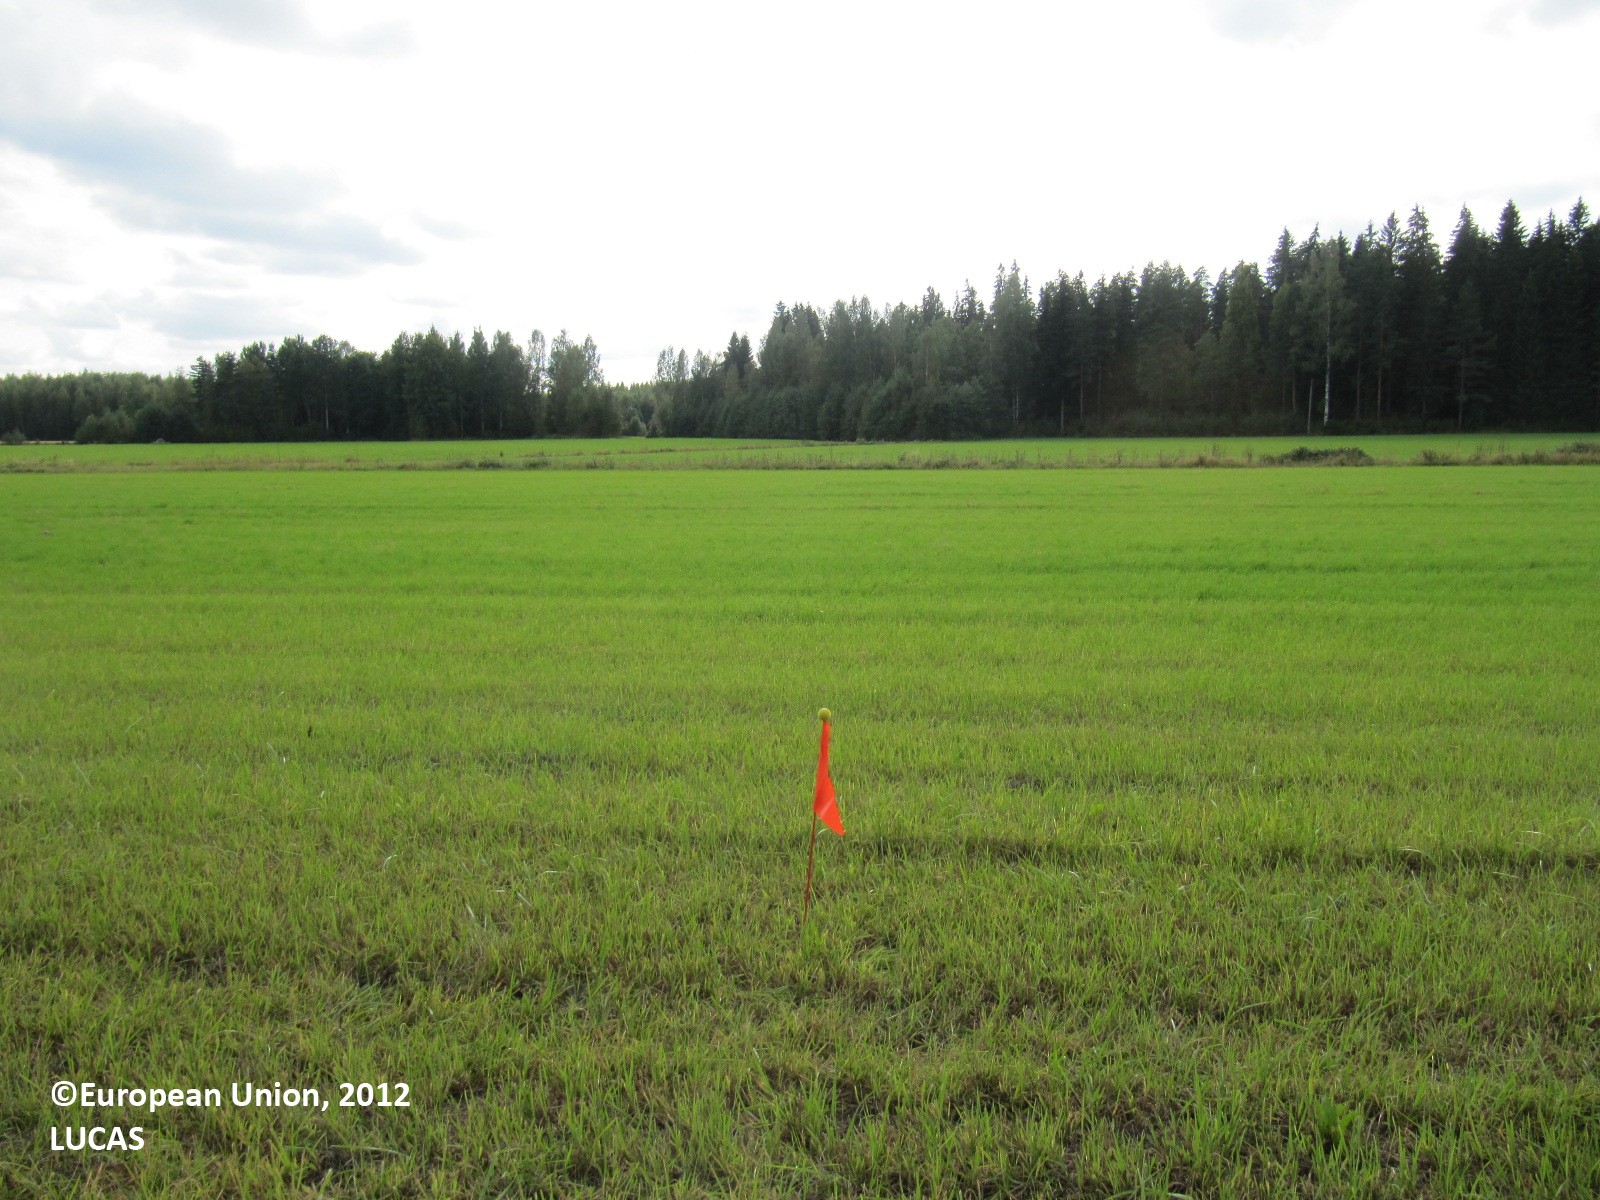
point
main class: Grassland
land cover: Spontaneously vegetated surfaces
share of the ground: > 75 %
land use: Agriculture (excluding fallow land and kitchen gardens)
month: August
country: FI
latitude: 61.0826
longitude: 22.9203
